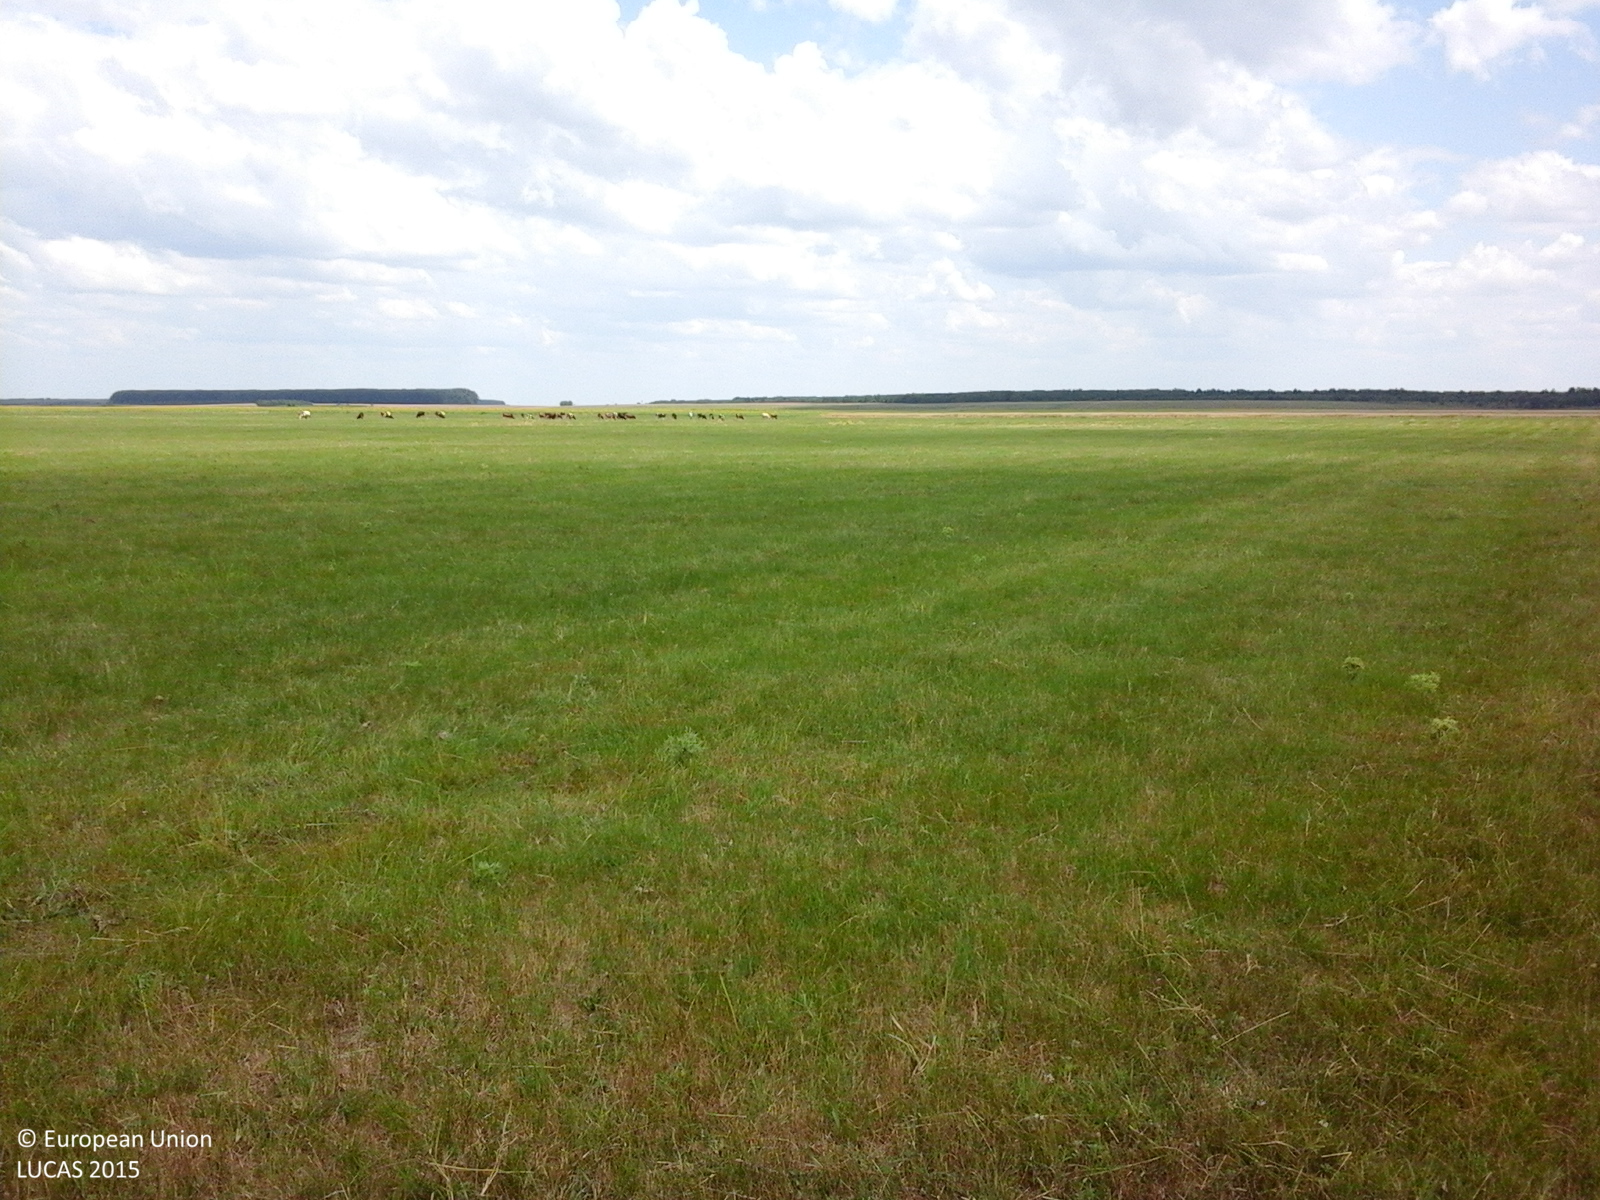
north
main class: Grassland
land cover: Grassland without tree/shrub cover
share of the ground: > 75 %
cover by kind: herbaceous plants 100 %
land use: Agriculture (excluding fallow land and kitchen gardens)
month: July
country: RO
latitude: 44.2118
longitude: 24.8307
